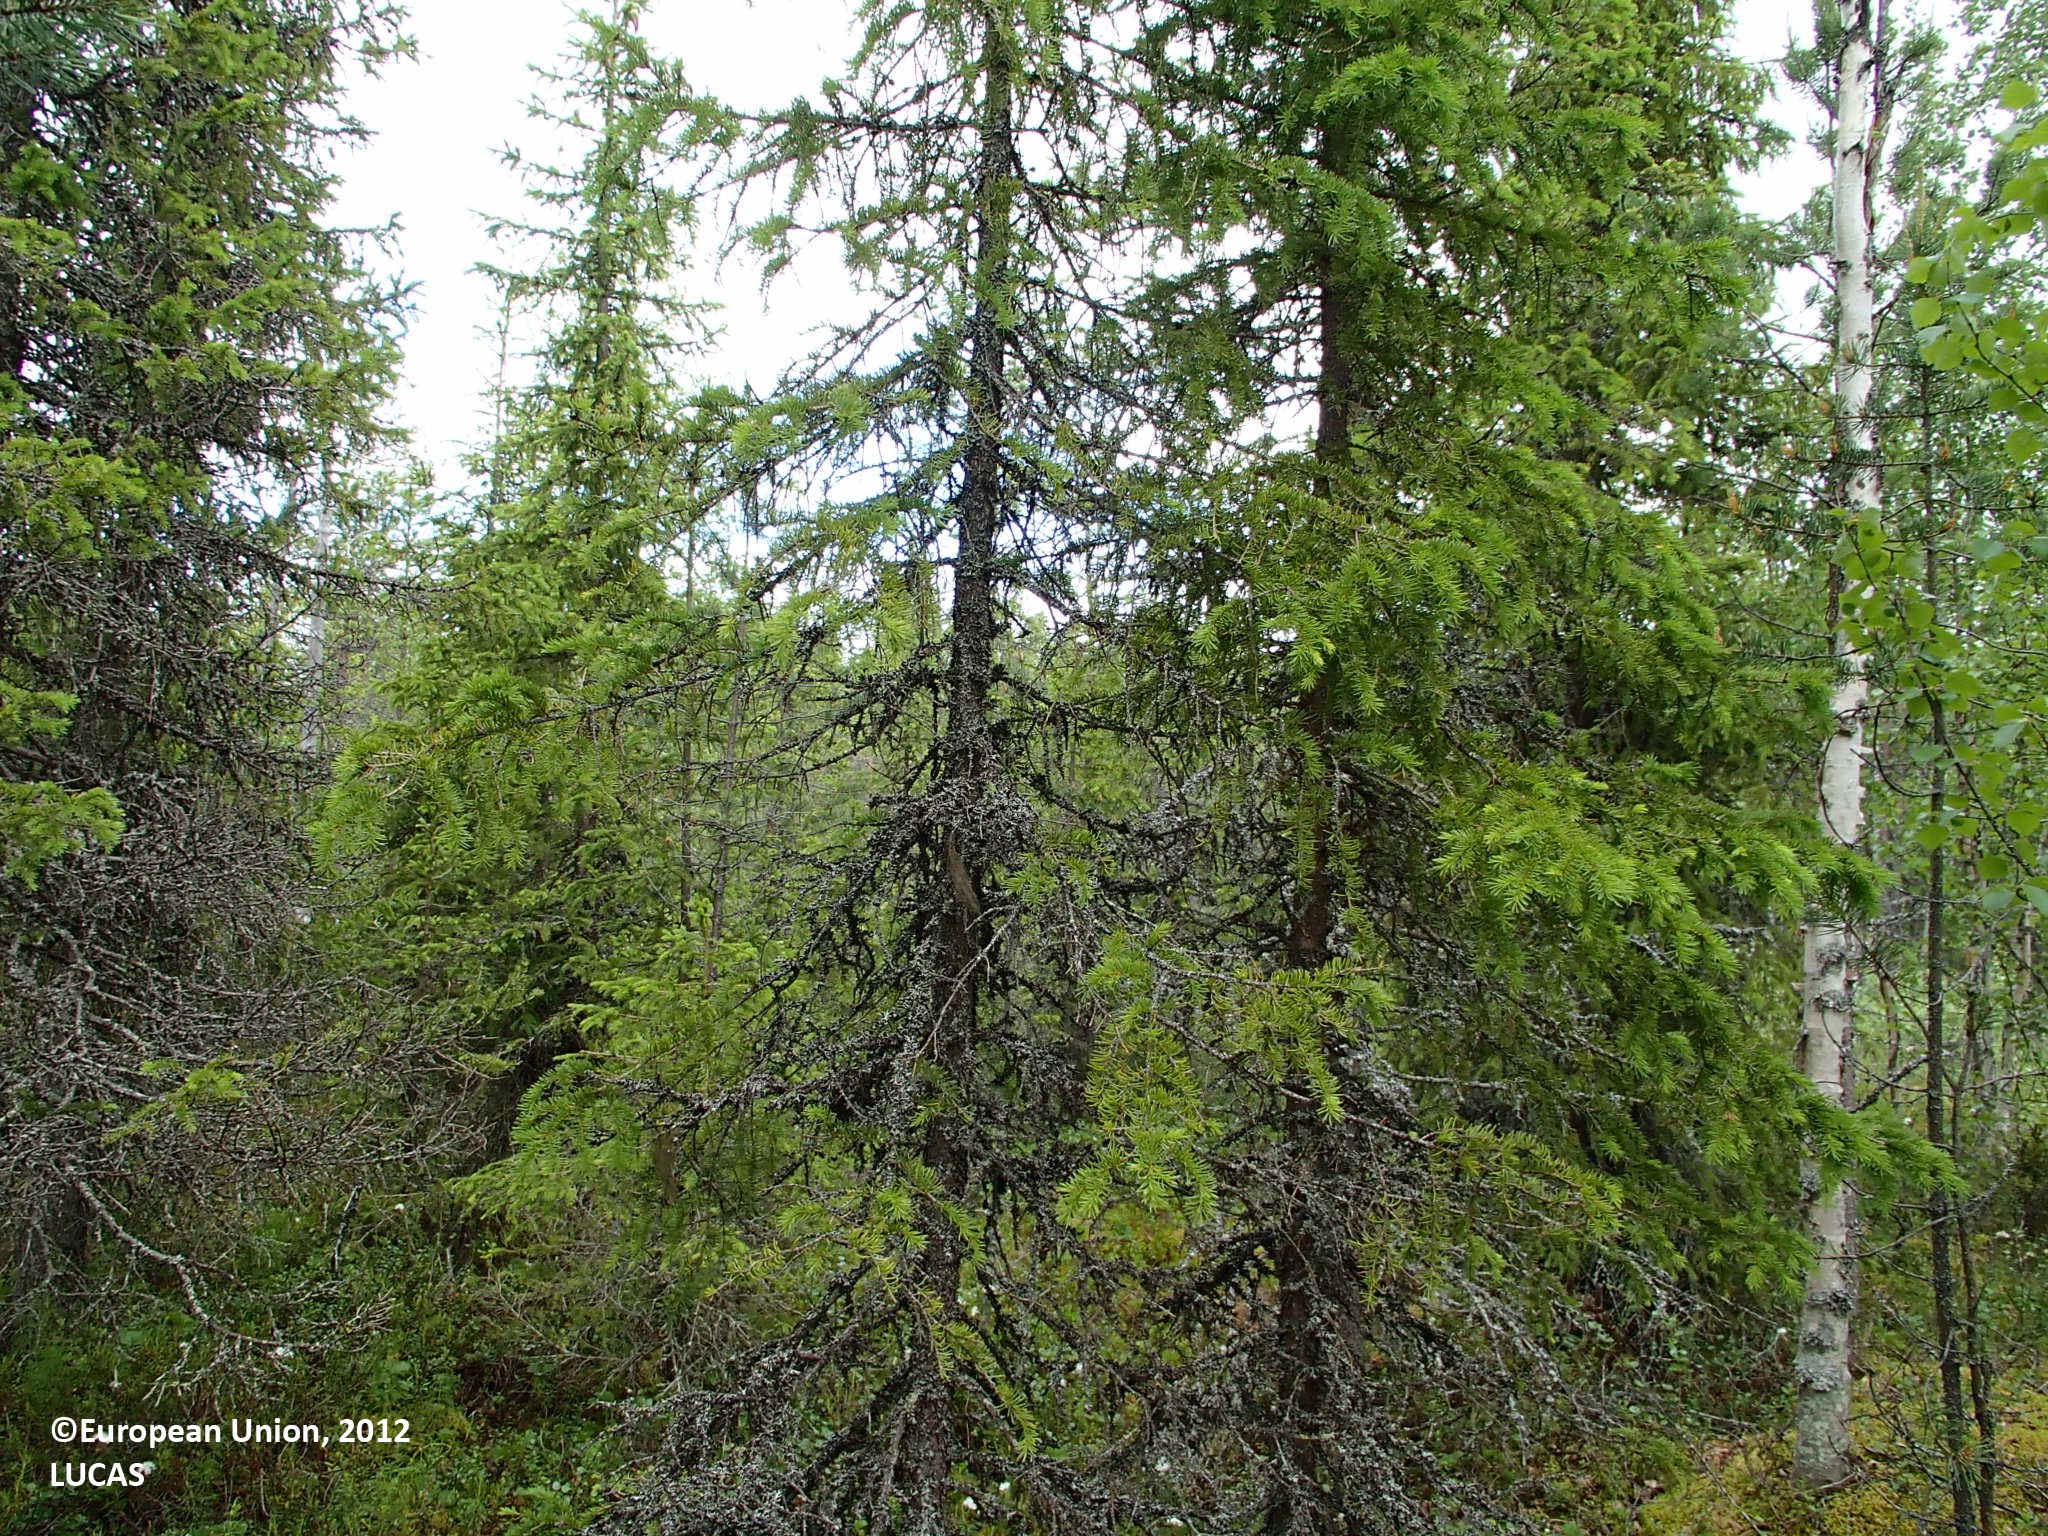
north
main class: Woodland
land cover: Spruce dominated coniferous woodland
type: boreal forest
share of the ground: > 75 %
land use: Forestry
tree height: > 5 m
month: July
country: FI
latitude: 66.9462
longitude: 27.9471
